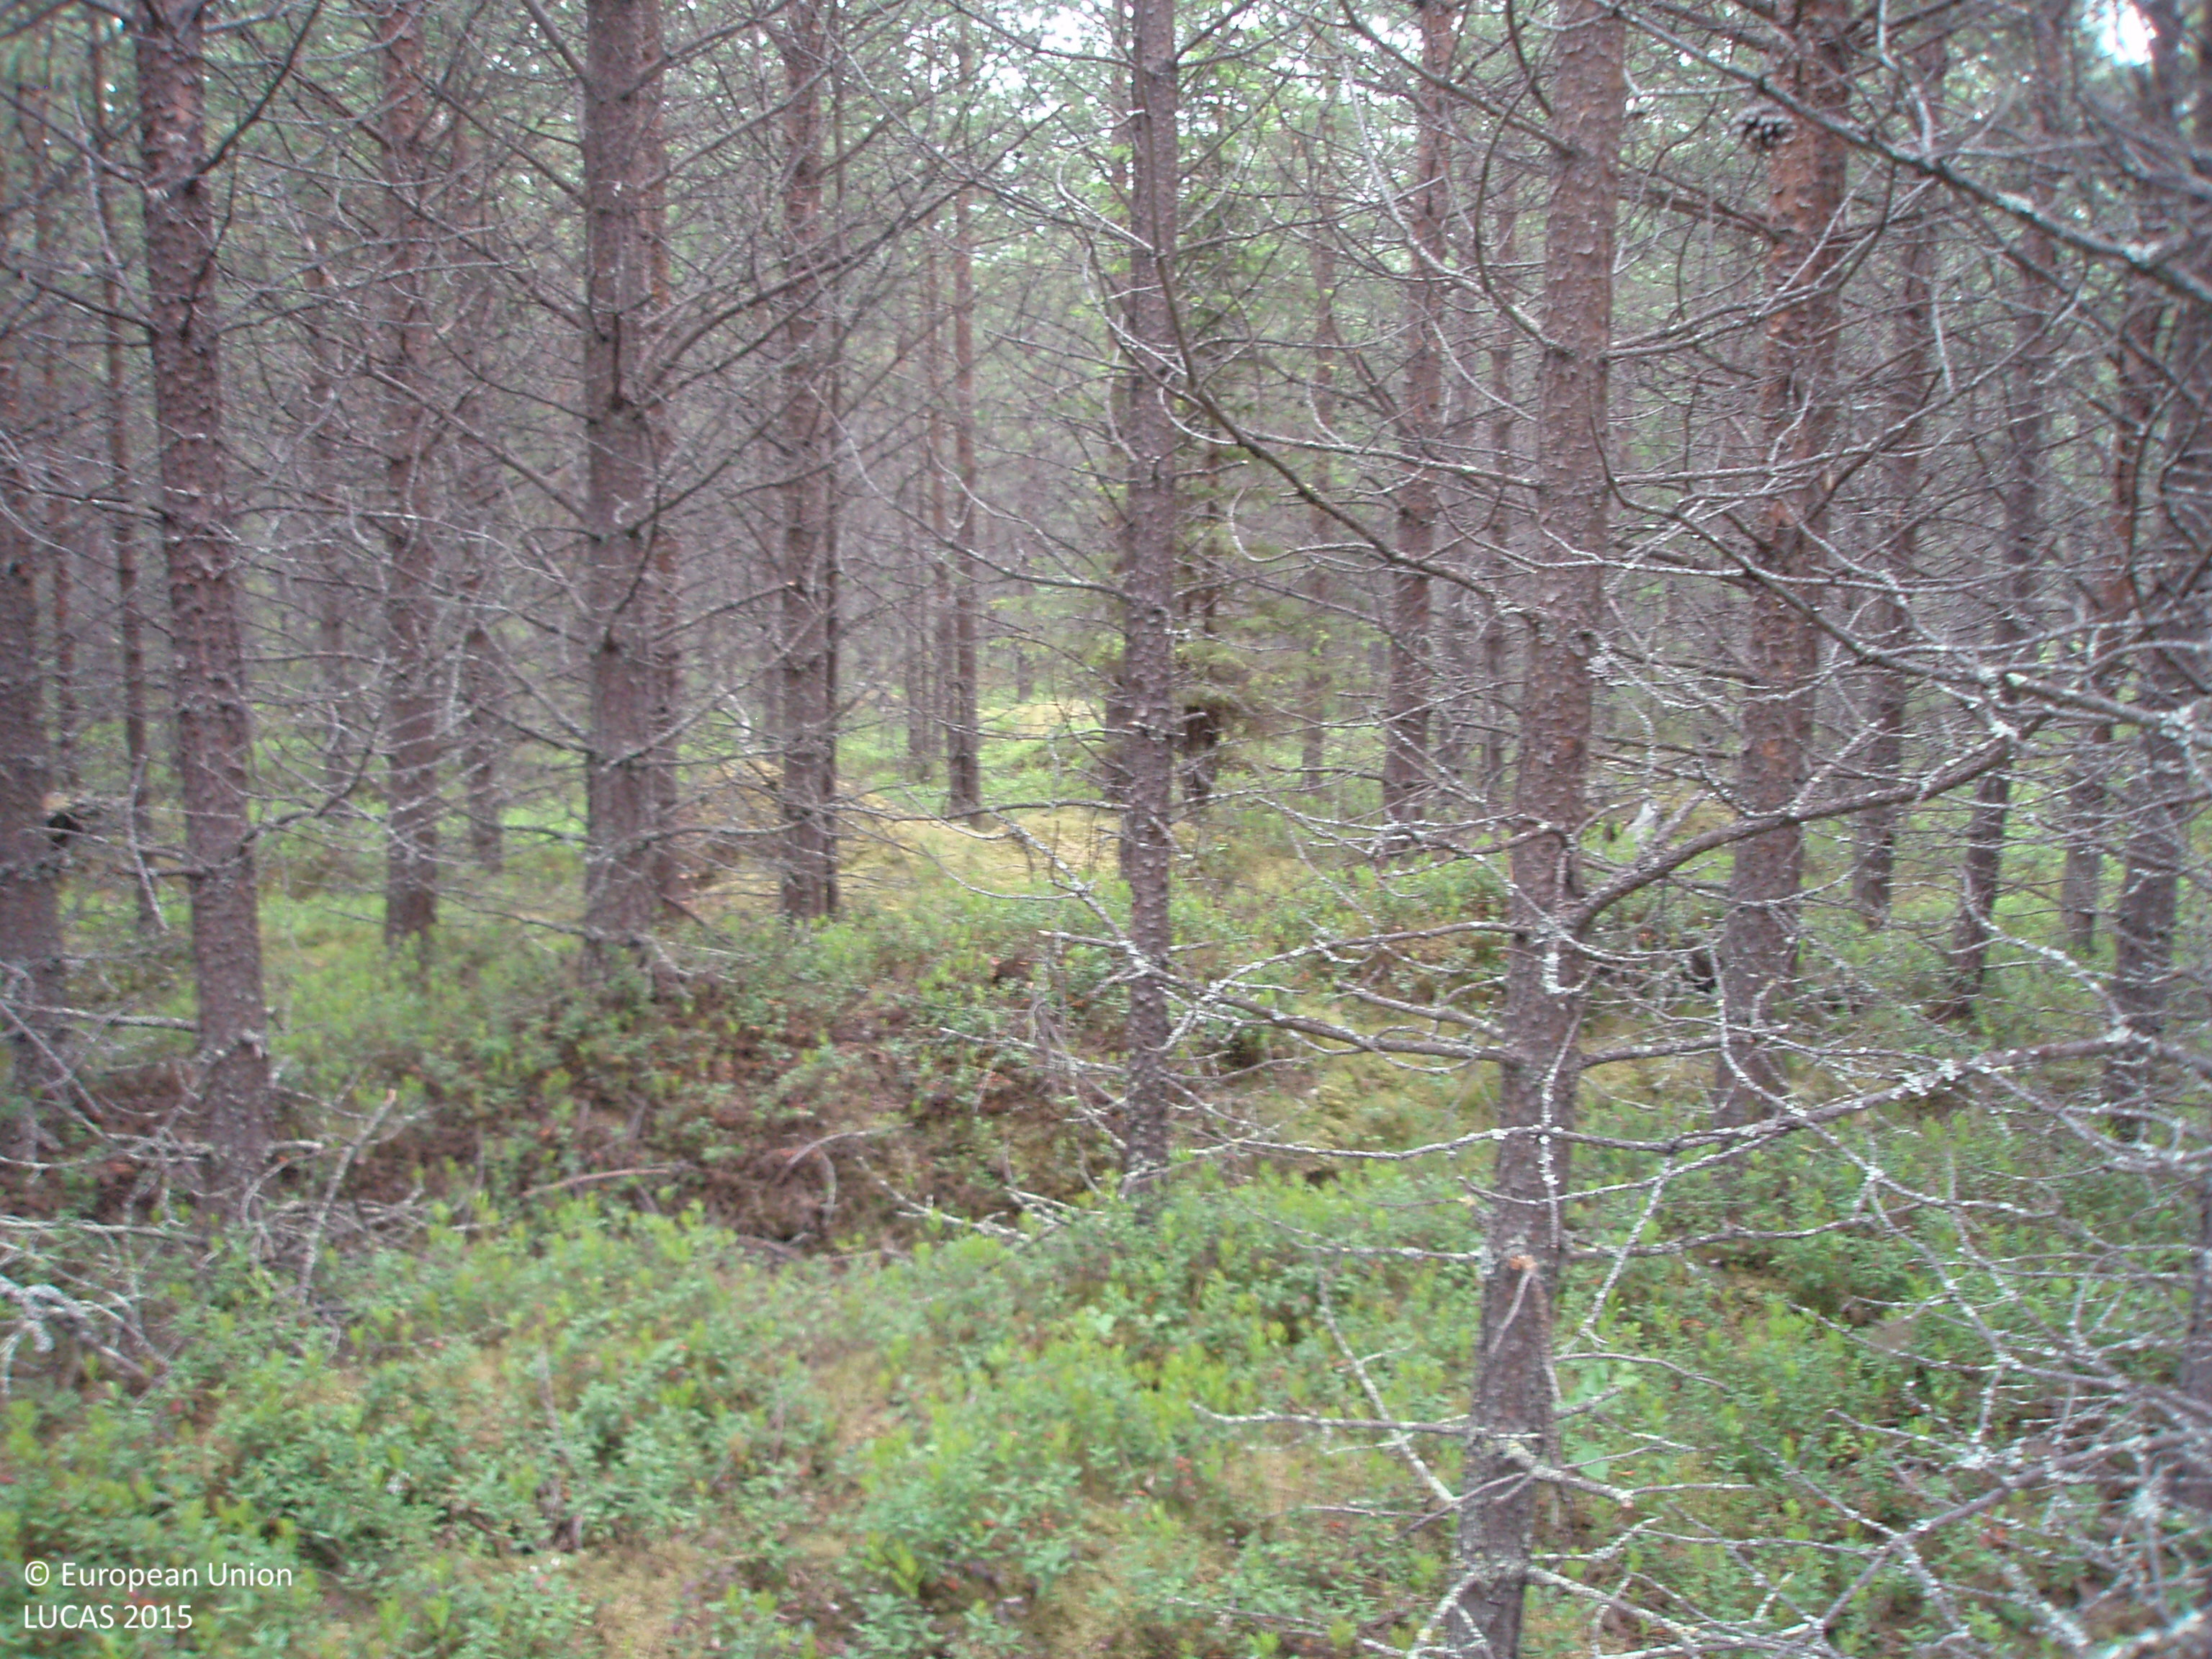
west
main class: Woodland
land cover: Pine dominated coniferous woodland
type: boreal forest
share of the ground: > 75 %
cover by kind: coniferous forest trees 90 %, shrubs 10 %
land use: Forestry
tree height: > 5 m
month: July
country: FI
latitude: 67.4833
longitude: 28.8853
